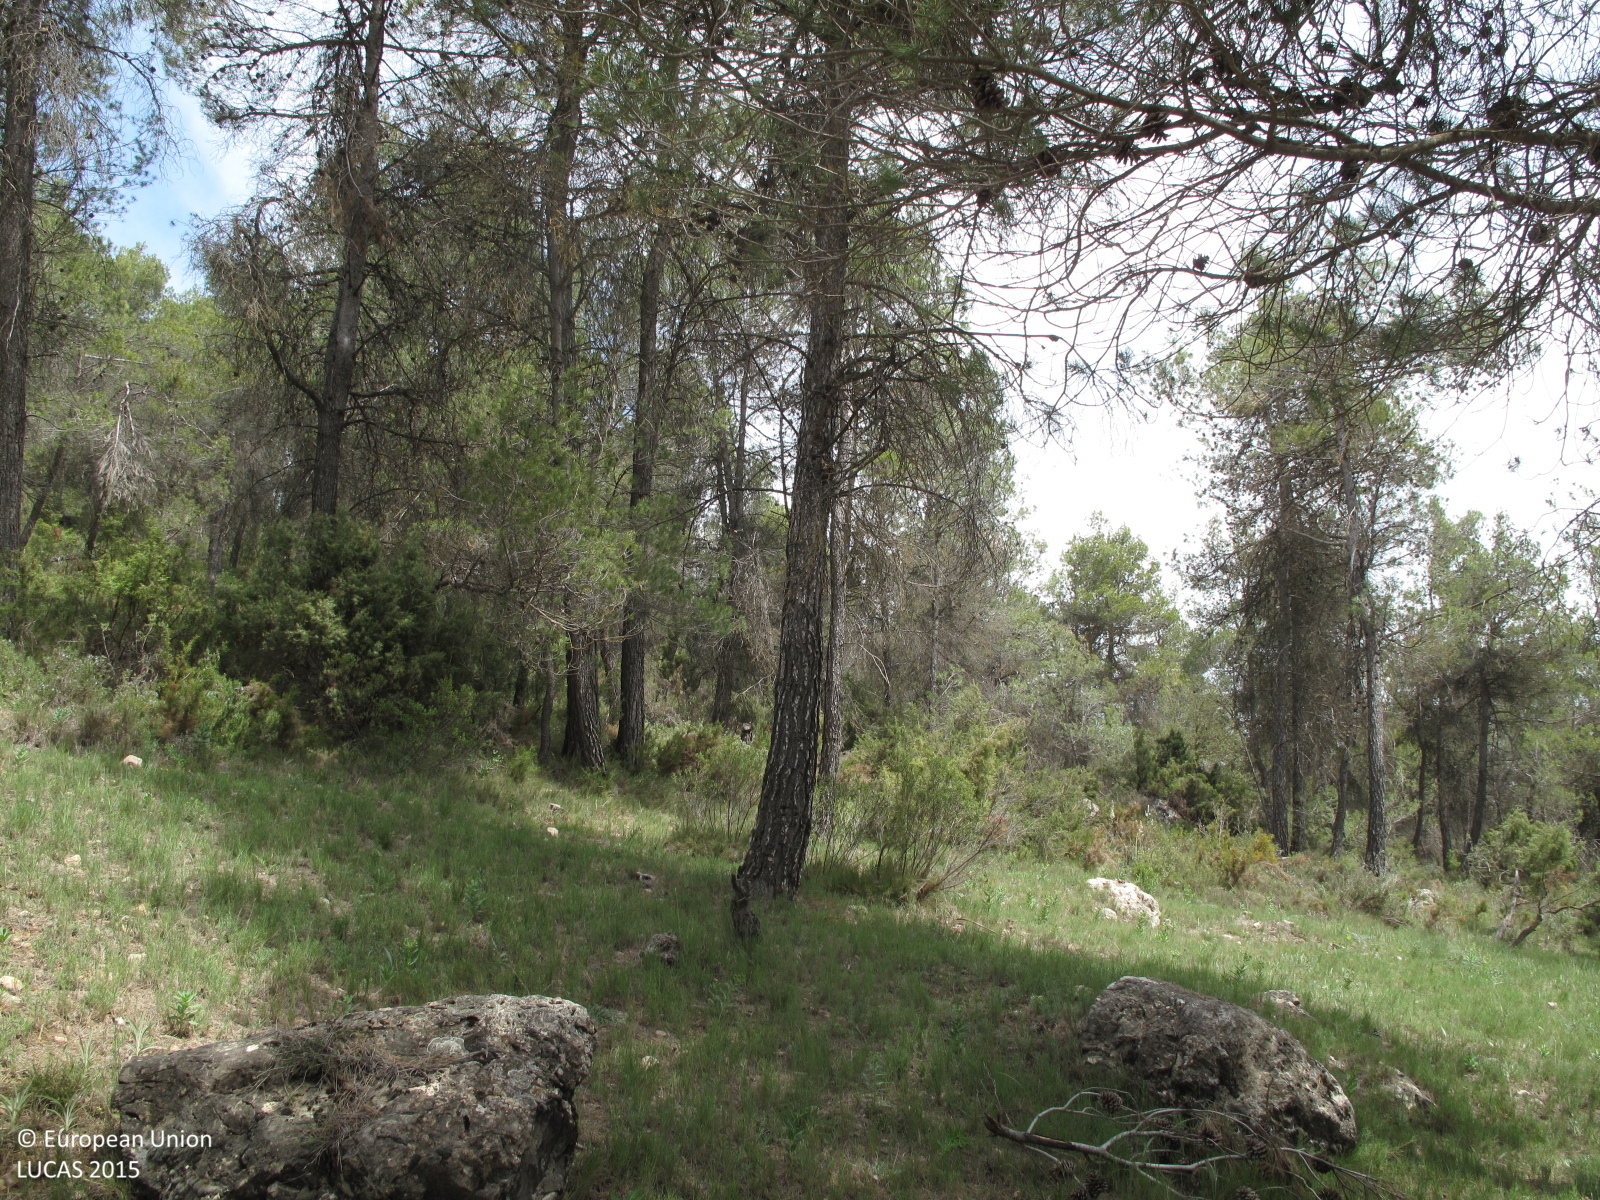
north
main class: Woodland
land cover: Pine dominated coniferous woodland
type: coniferous forest of the mediterranean region
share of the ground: 50 - 75 %
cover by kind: coniferous forest trees 50 %, consolidated bare surface 25 %, herbaceous plants 20 %, shrubs 5 %
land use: Semi-natural and natural areas not in use
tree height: > 5 m
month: May
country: ES
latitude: 38.7492
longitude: -0.5413
